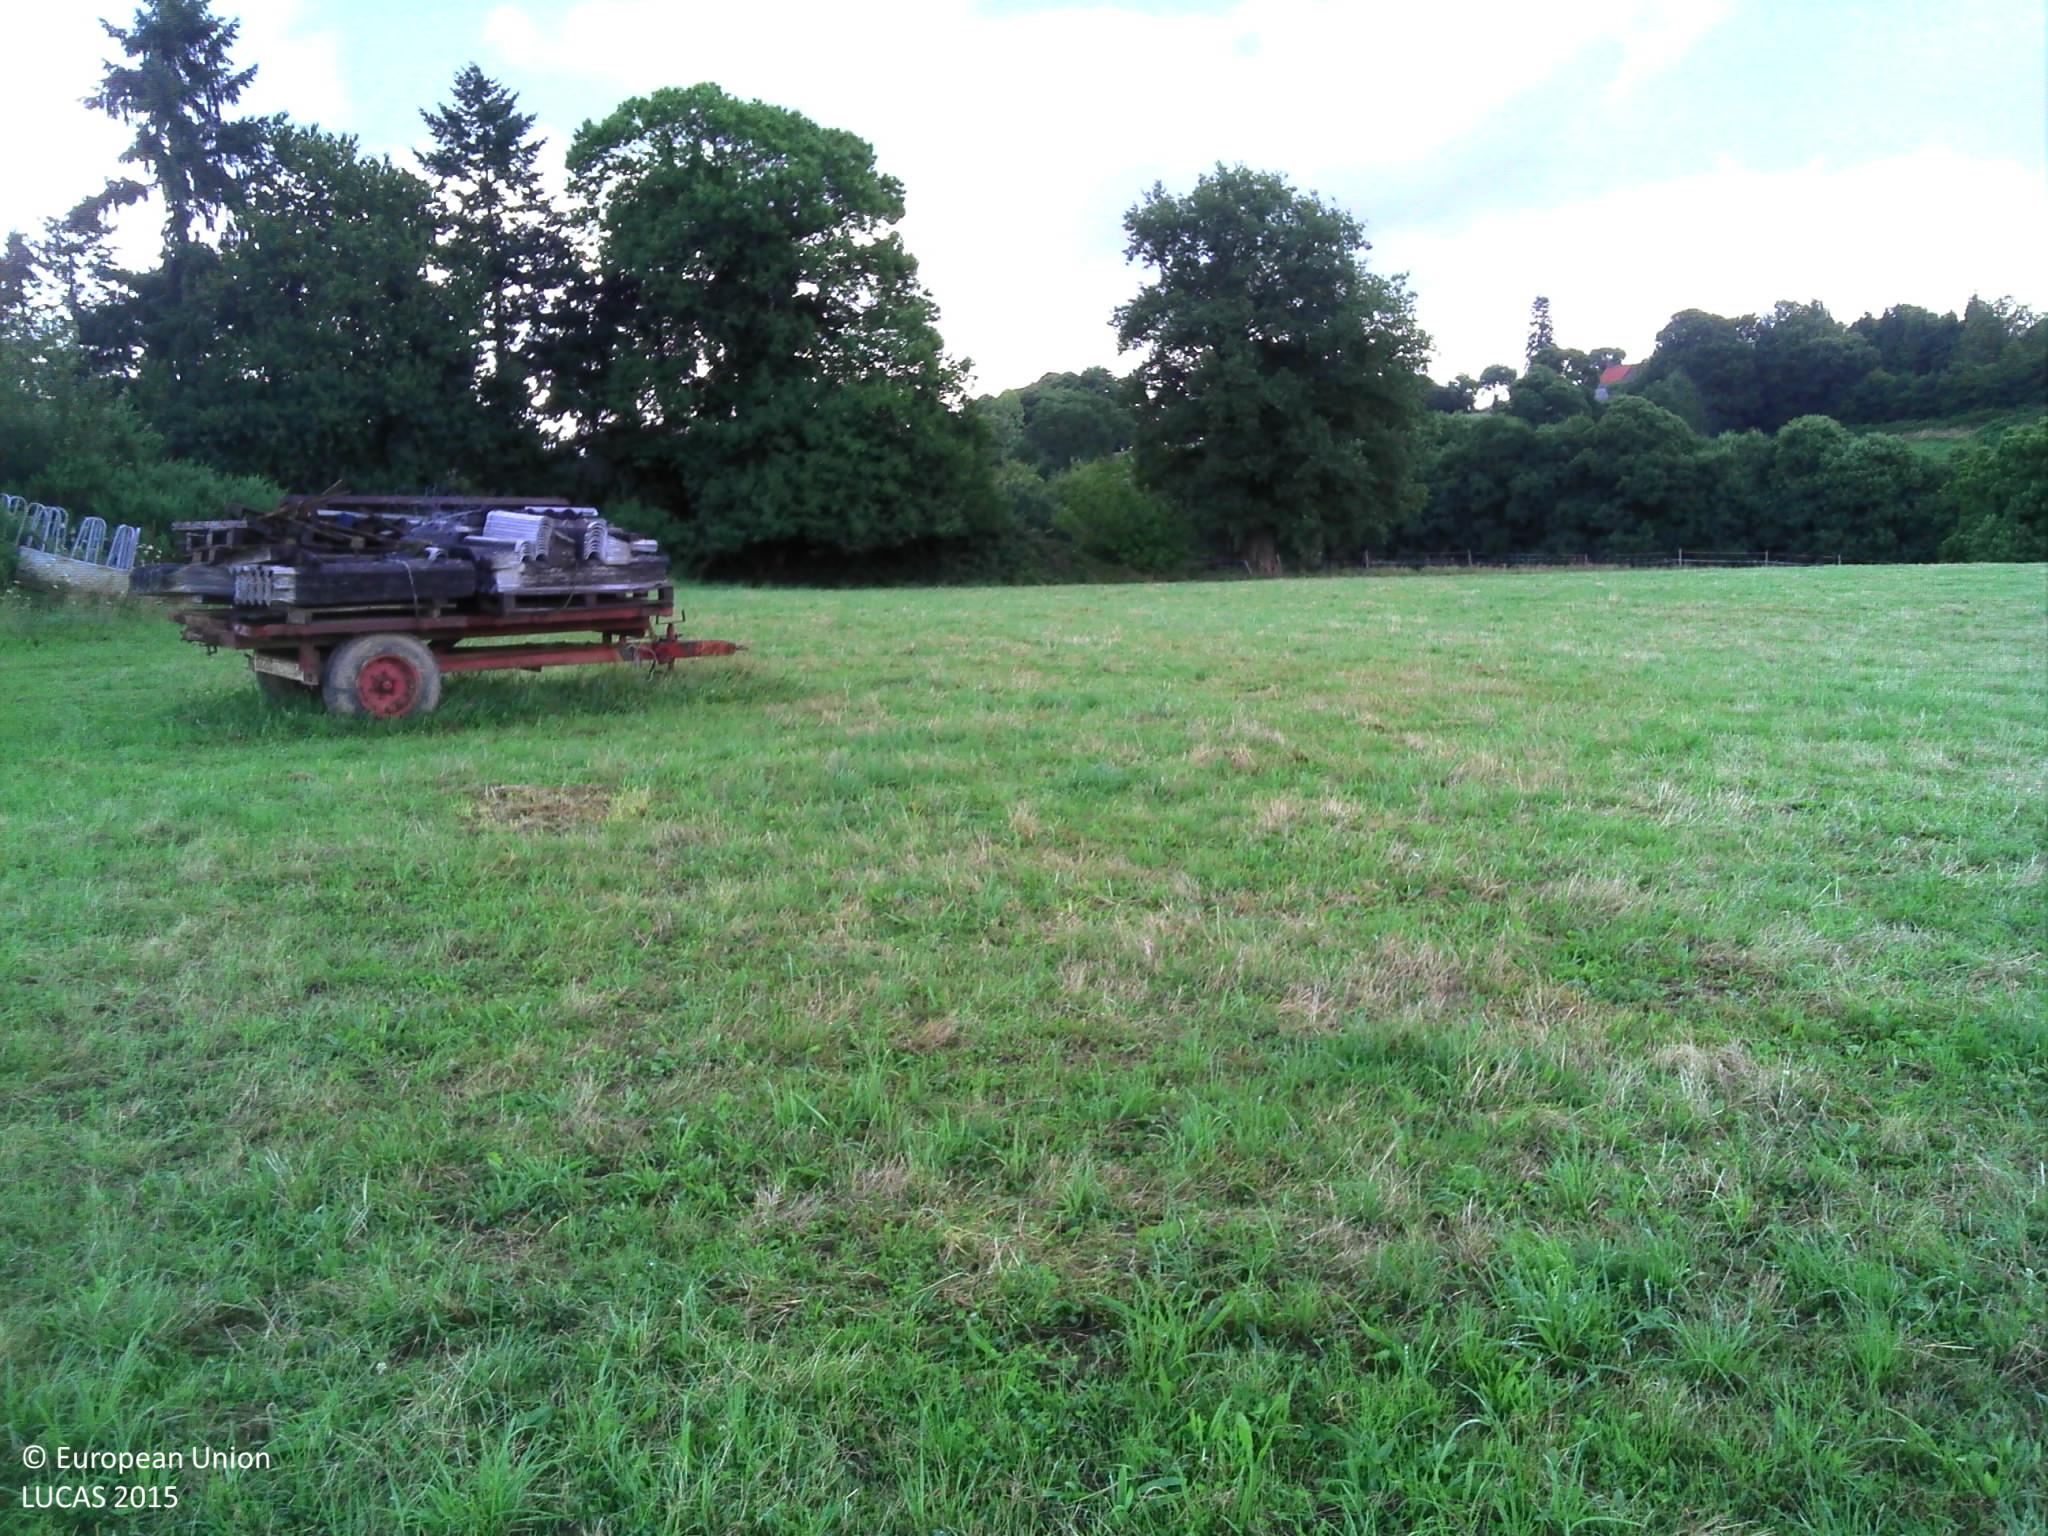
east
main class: Grassland
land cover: Grassland without tree/shrub cover
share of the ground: > 75 %
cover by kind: herbaceous plants 100 %
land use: Agriculture (excluding fallow land and kitchen gardens)
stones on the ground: < 10 %
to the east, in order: Grassland without tree/shrub cover; Broadleaved woodland; Fences; Grassland without tree/shrub cover; Fences; Grassland without tree/shrub cover; Fences; Broadleaved woodland; Grassland without tree/shrub cover; Rivers and streams; Grassland without tree/shrub cover; Broadleaved woodland
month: July
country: FR
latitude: 48.7371
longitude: -1.2348
